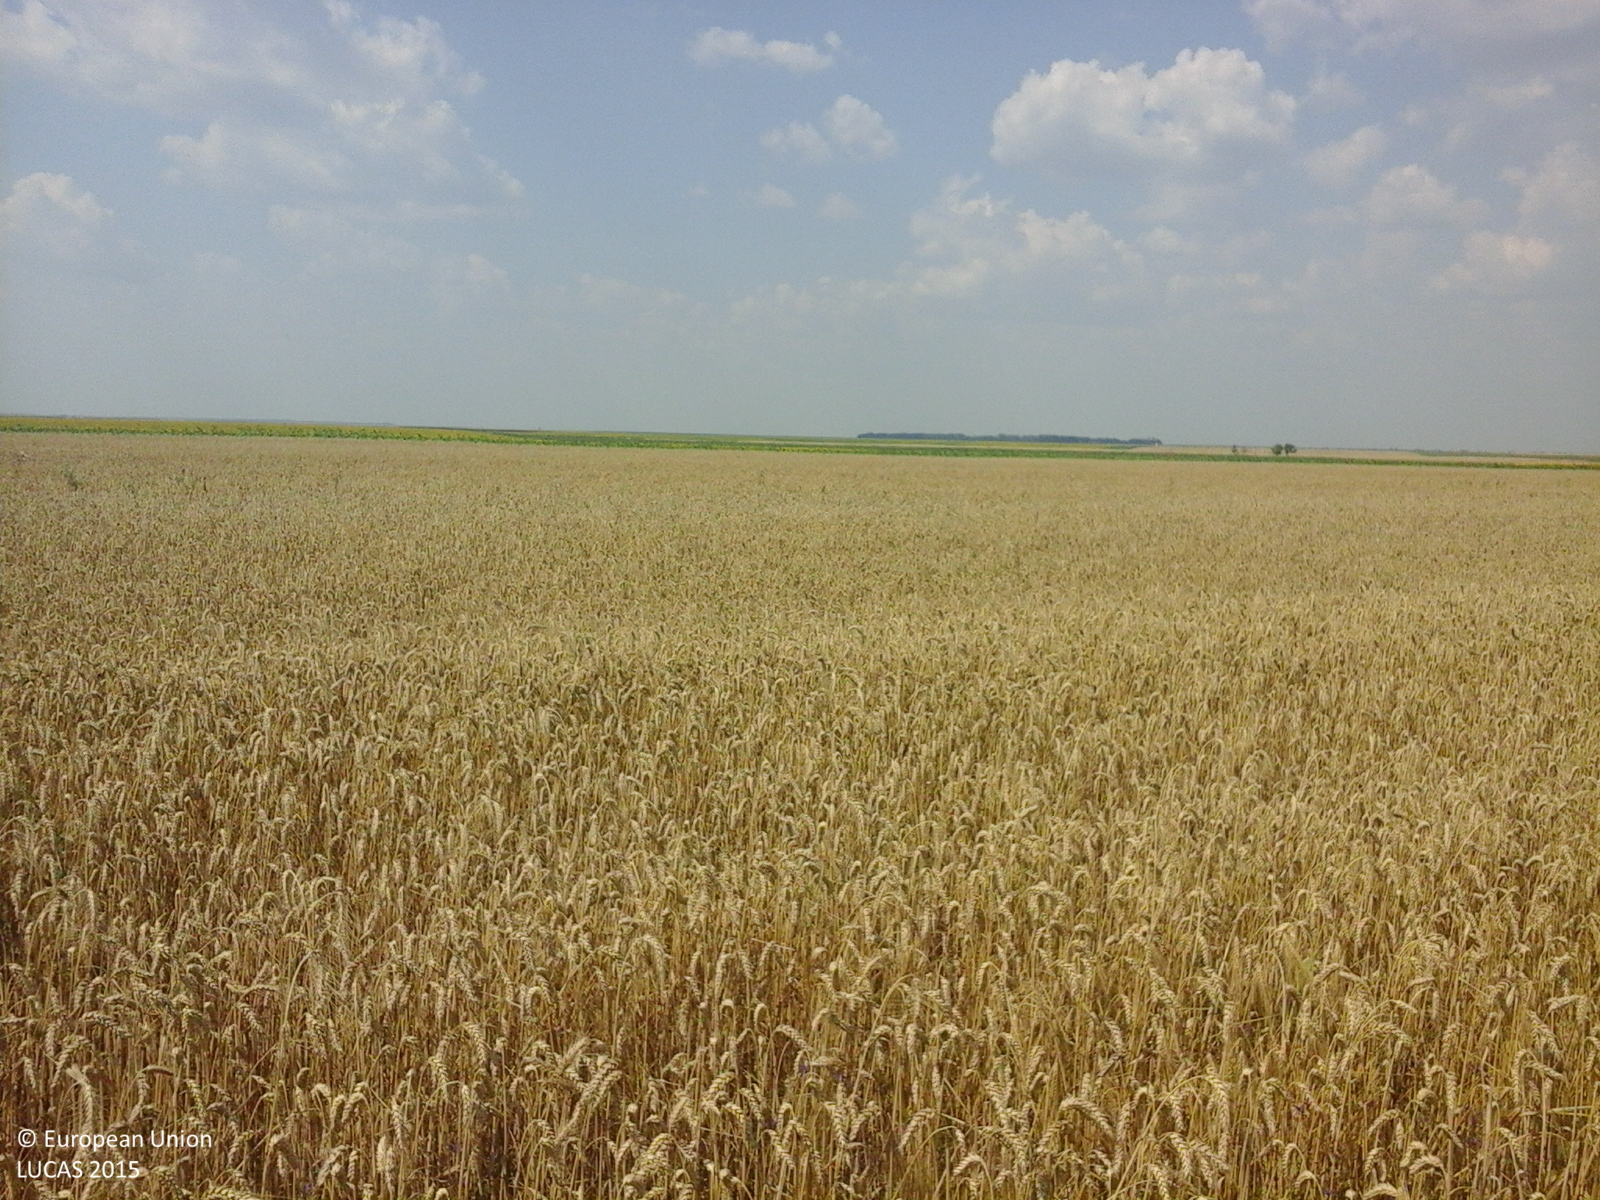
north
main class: Cropland
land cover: Durum wheat
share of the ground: > 75 %
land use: Agriculture (excluding fallow land and kitchen gardens)
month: July
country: RO
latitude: 43.8449
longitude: 24.8360
